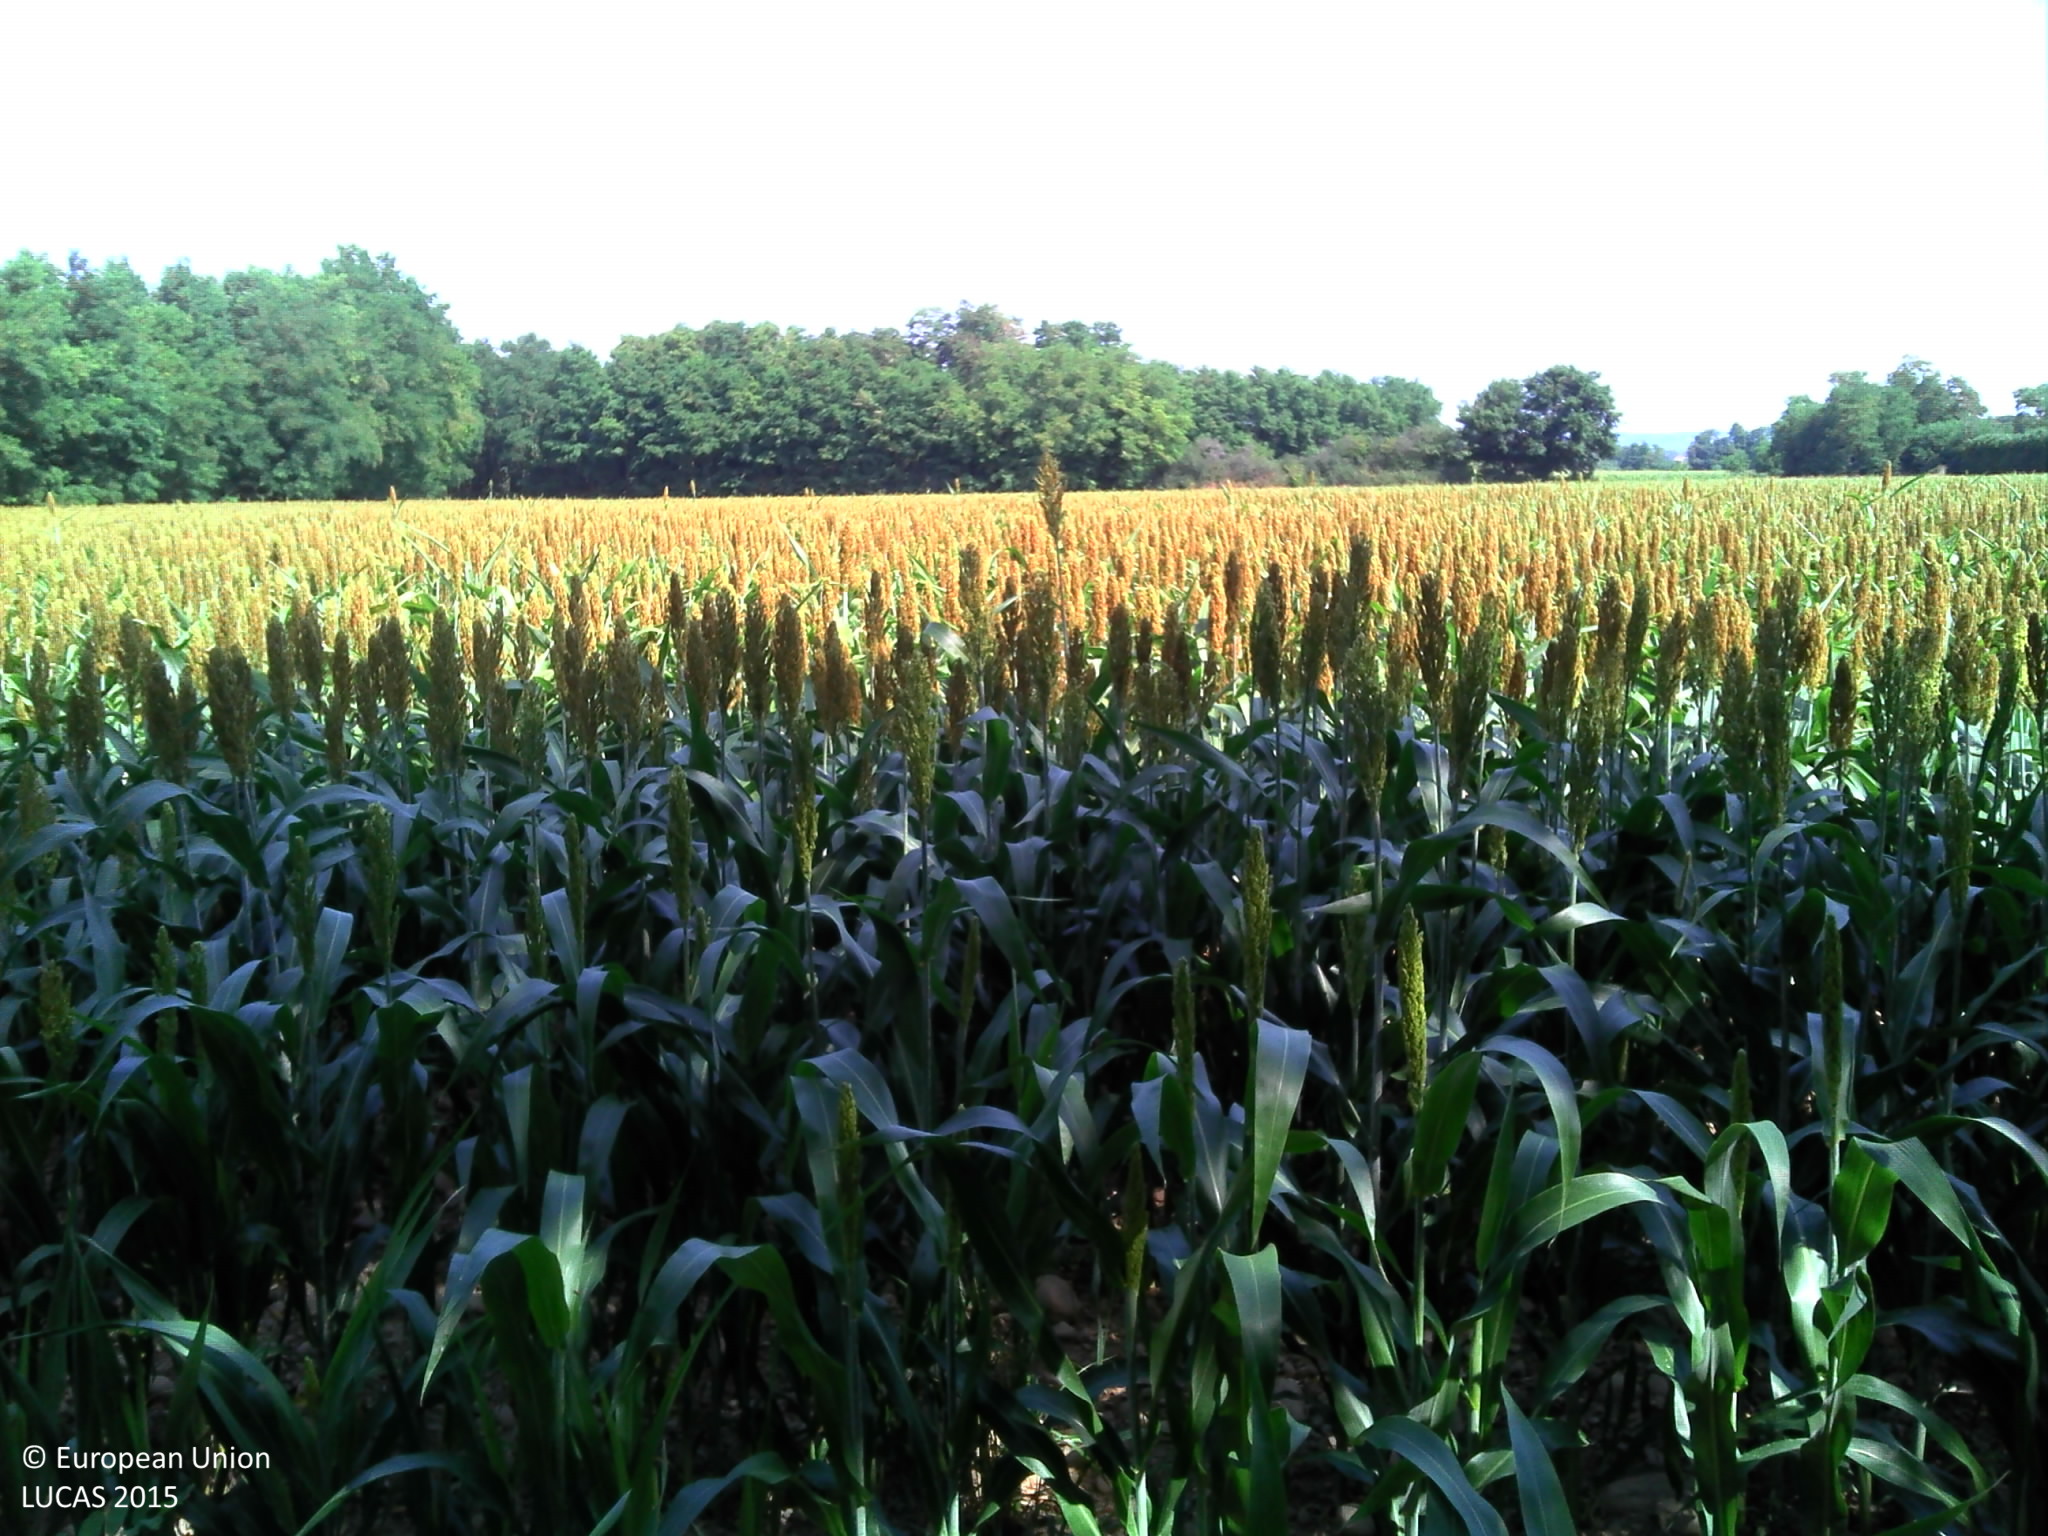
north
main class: Cropland
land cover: Other cereals
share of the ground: > 75 %
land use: Agriculture (excluding fallow land and kitchen gardens)
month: July
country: FR
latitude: 45.3325
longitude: 5.0157
